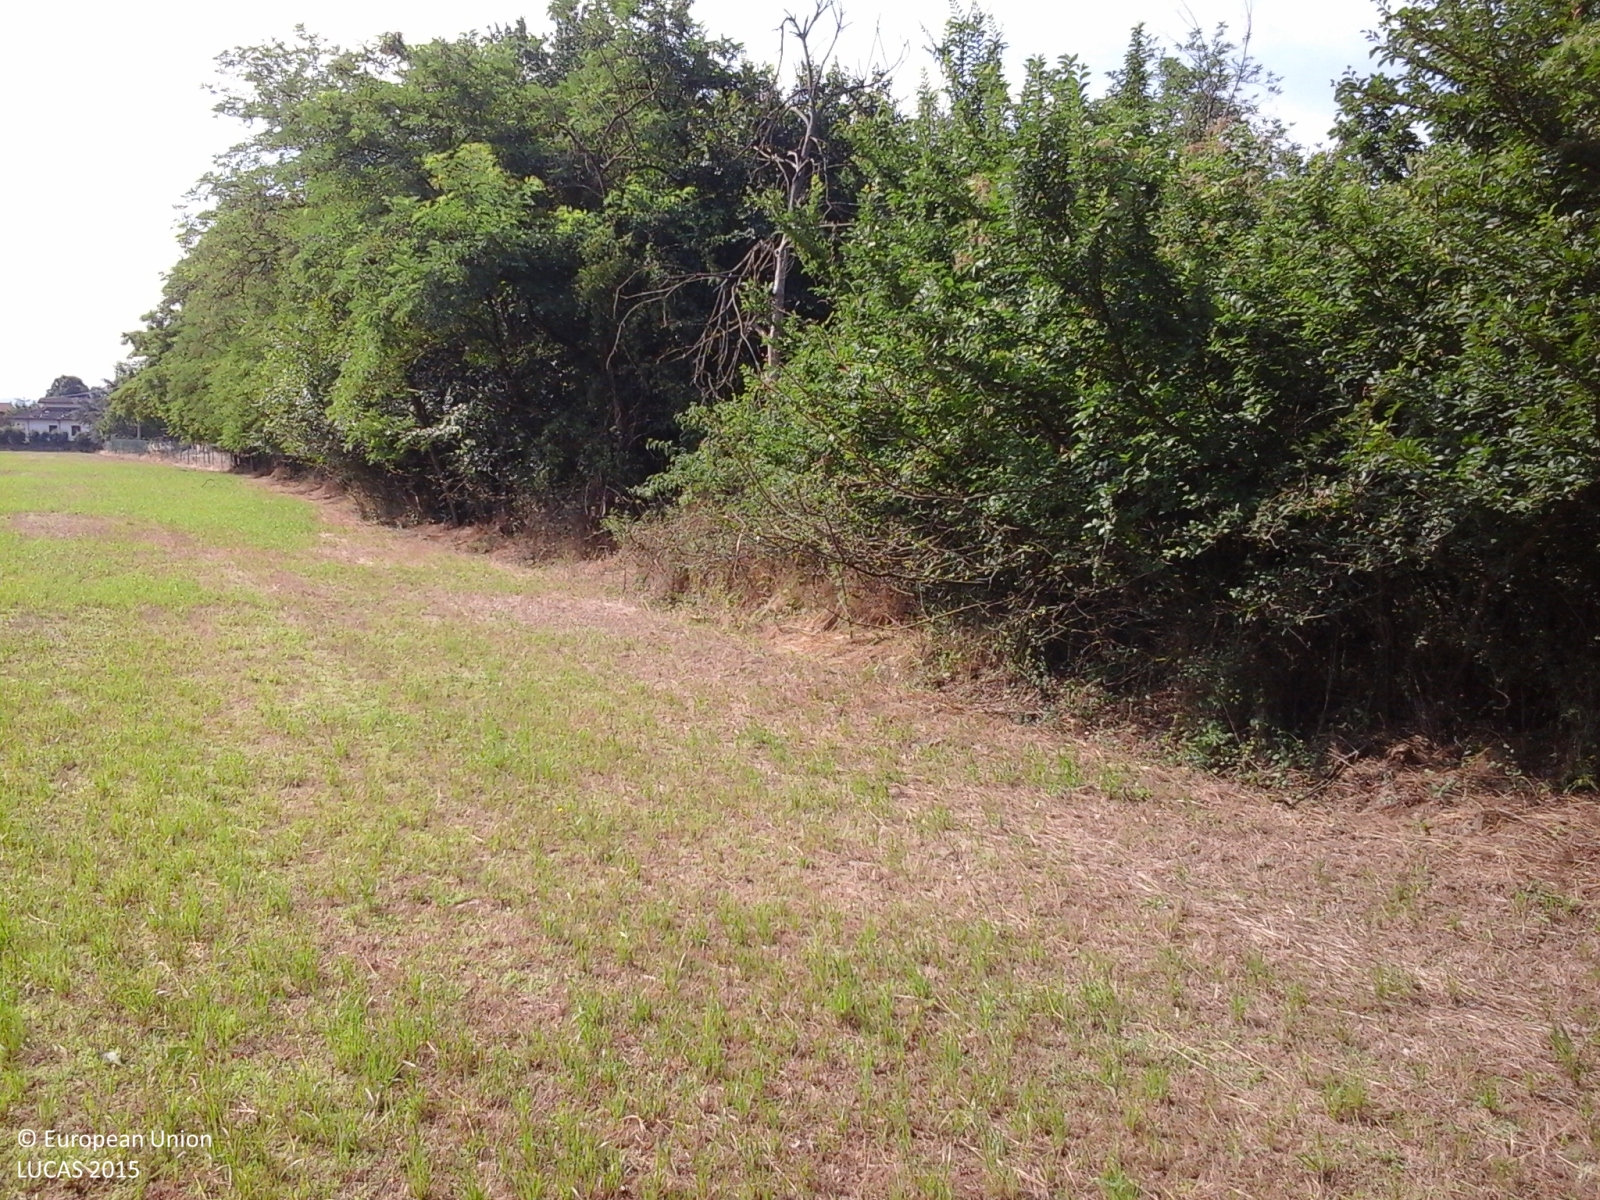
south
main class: Cropland
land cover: Temporary grasslands
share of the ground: > 75 %
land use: Agriculture (excluding fallow land and kitchen gardens)
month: June
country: IT
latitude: 44.7395
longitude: 8.7271
